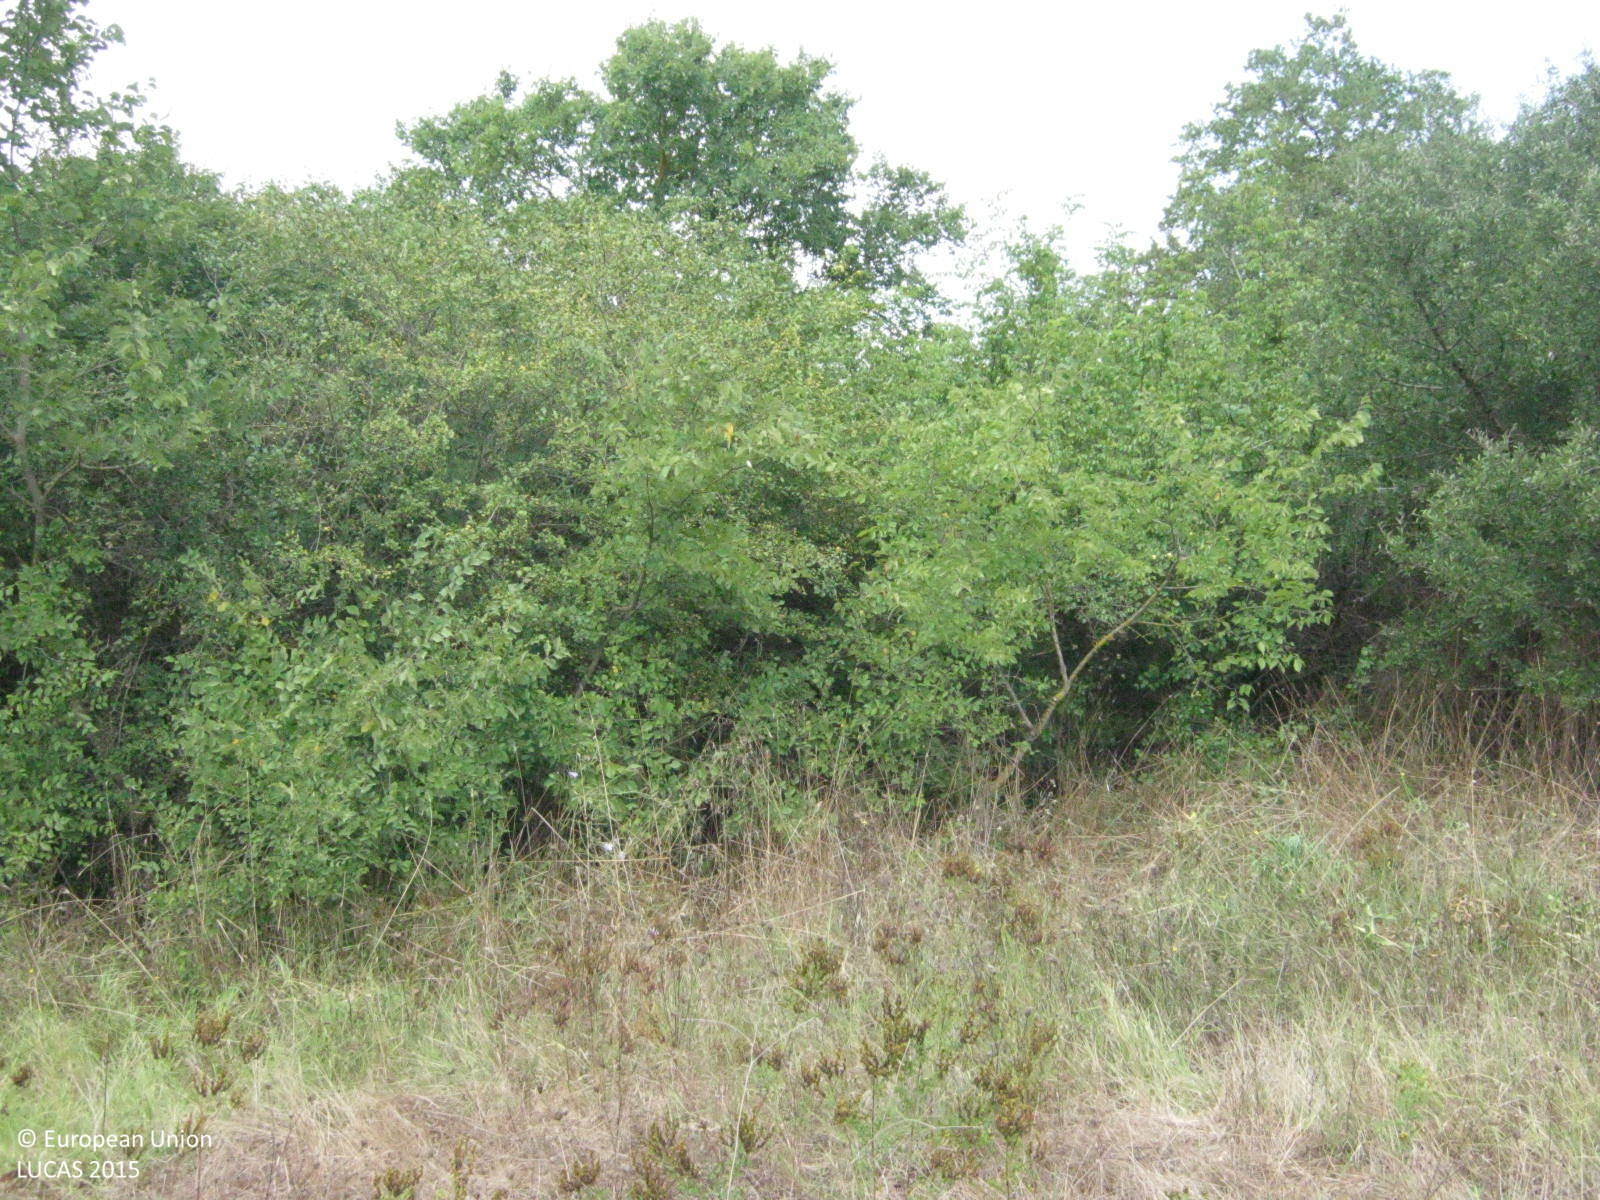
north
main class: Shrubland
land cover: Shrubland with sparse tree cover
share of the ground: > 75 %
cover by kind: shrubs 95 %, coniferous forest trees 5 %
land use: Semi-natural and natural areas not in use
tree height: < 5 m
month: August
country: GR
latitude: 40.9213
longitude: 22.9656
